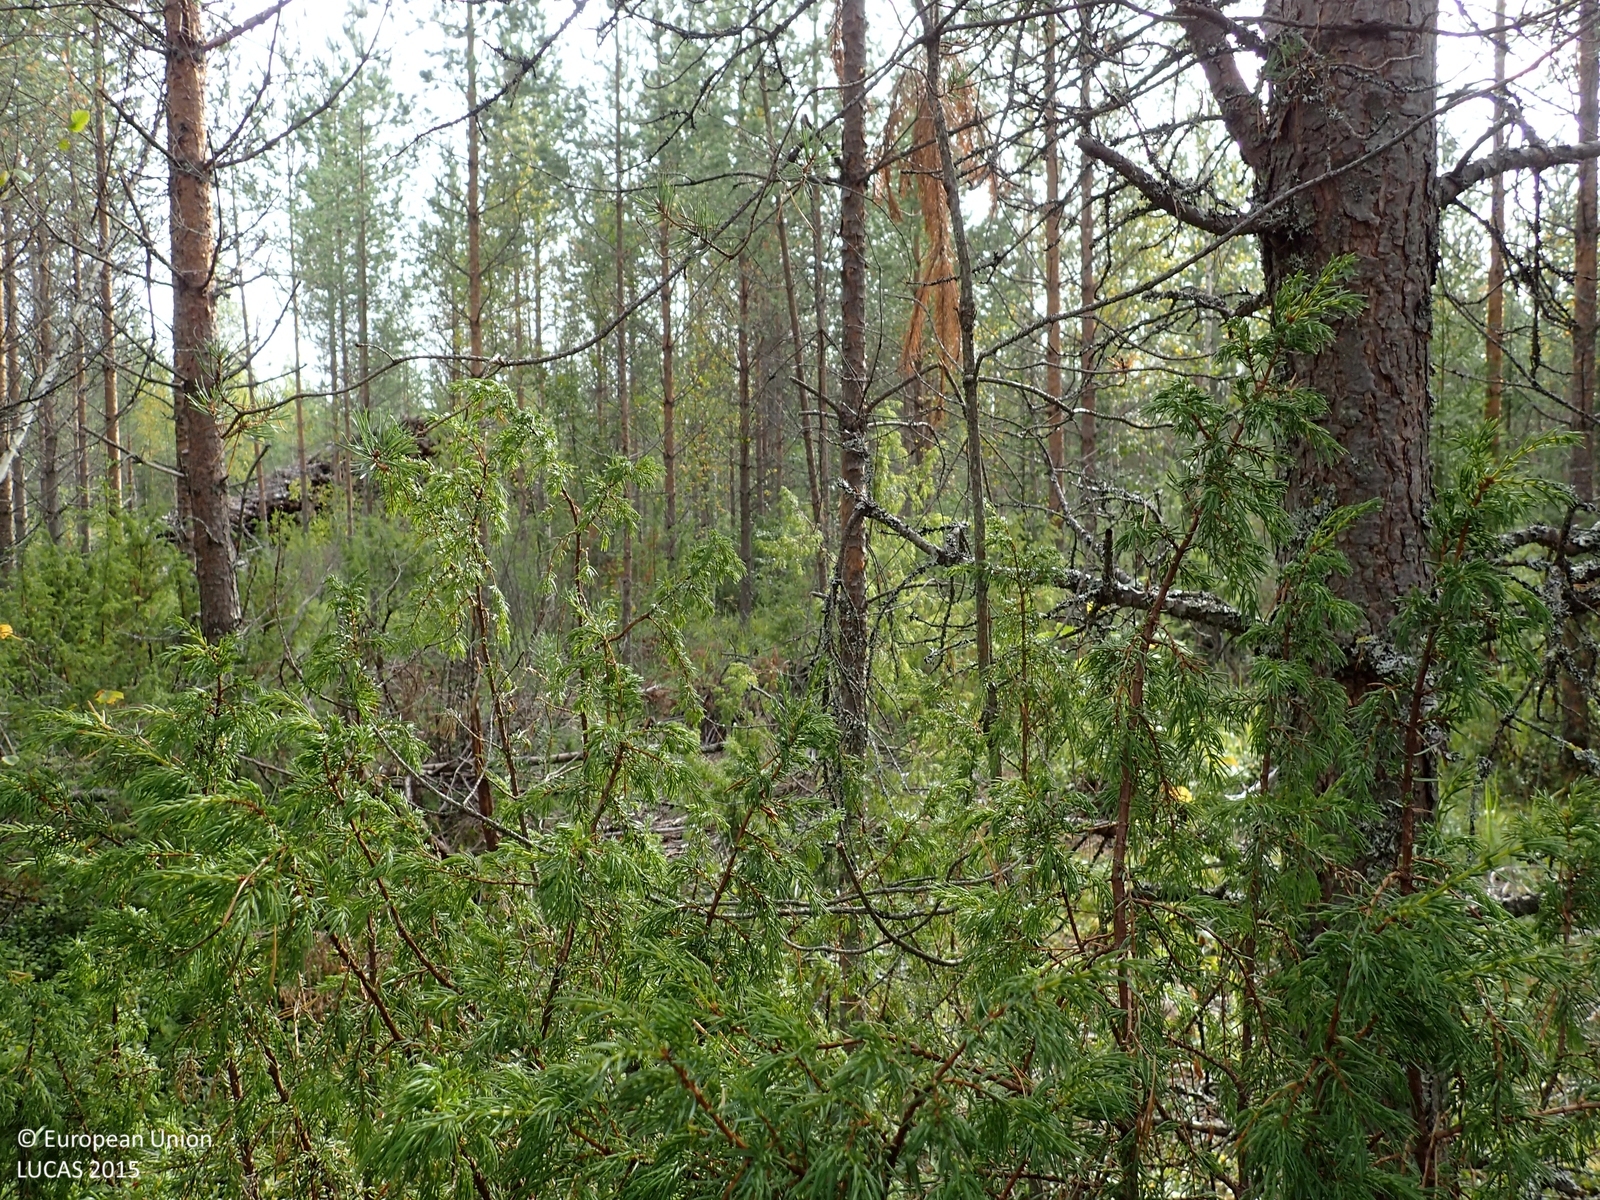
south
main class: Woodland
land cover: Pine dominated mixed woodland
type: boreal forest
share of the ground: > 75 %
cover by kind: coniferous forest trees 55 %, shrubs 25 %, broadleaved forest trees 20 %
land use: Forestry
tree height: > 5 m
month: September
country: FI
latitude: 63.0824
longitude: 26.1395
